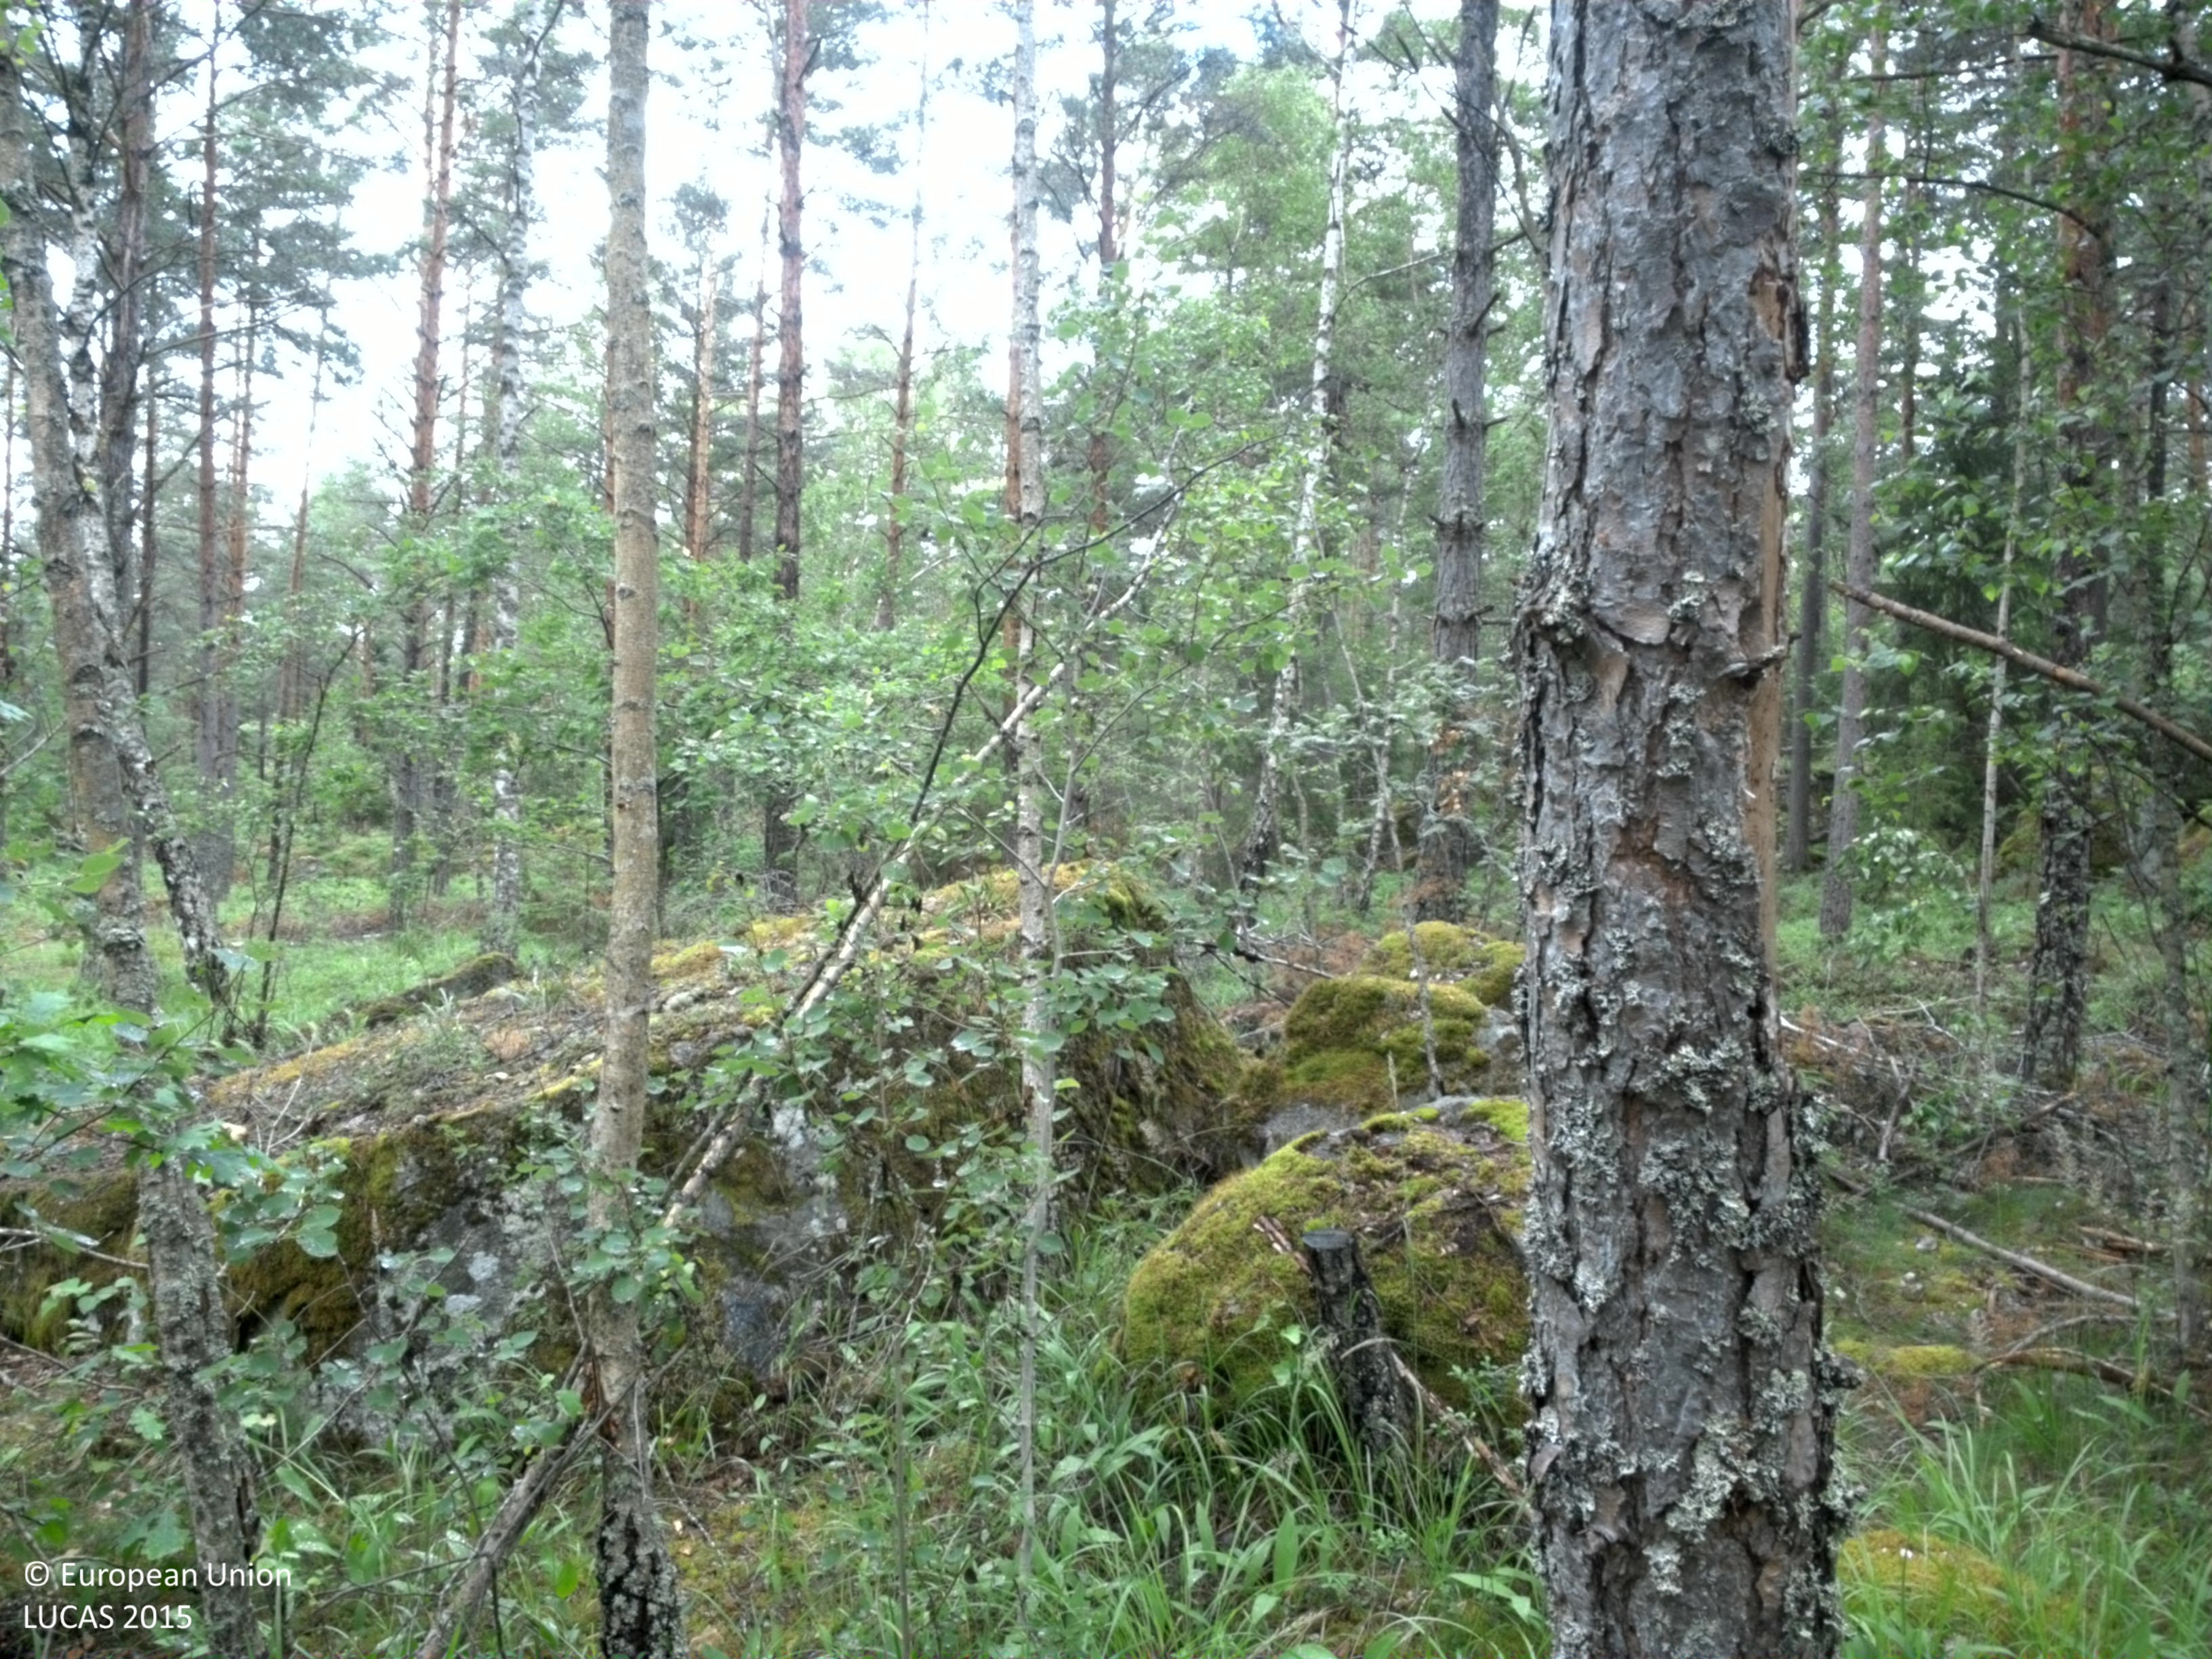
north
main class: Woodland
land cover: Pine dominated coniferous woodland
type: boreal forest
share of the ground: 50 - 75 %
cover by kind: coniferous forest trees 60 %, herbaceous plants 30 %, broadleaved forest trees 10 %
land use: Forestry
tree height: > 5 m
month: July
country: SE
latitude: 59.7906
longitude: 17.6743
